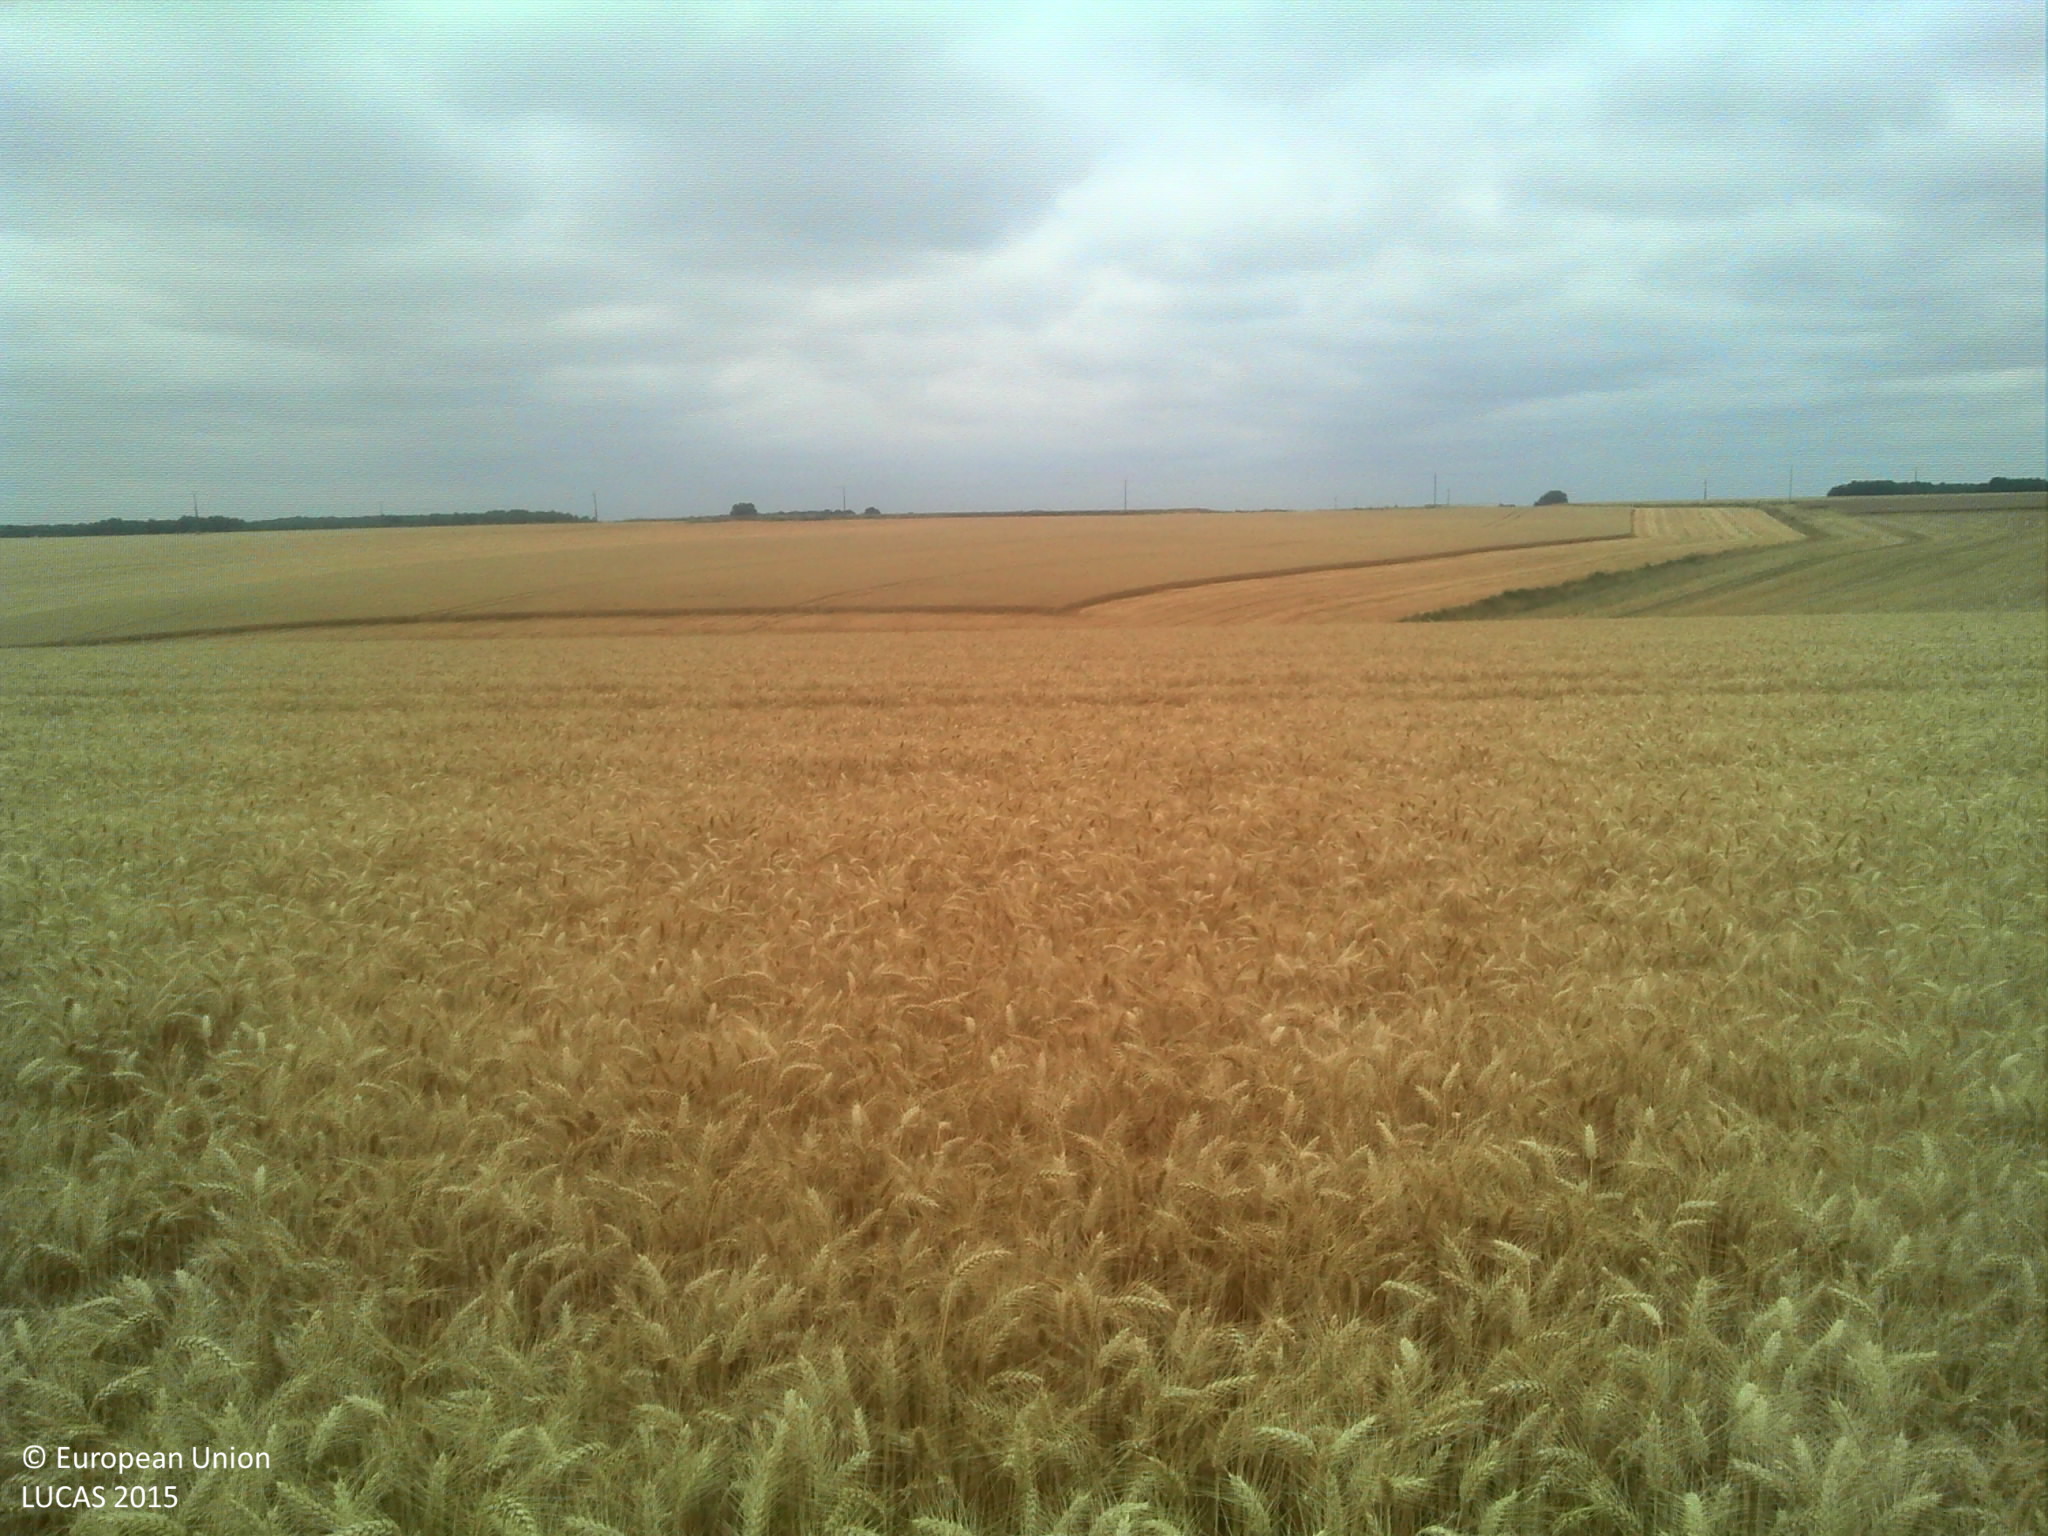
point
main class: Cropland
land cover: Common wheat
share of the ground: > 75 %
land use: Agriculture (excluding fallow land and kitchen gardens)
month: July
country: FR
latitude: 47.7244
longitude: 0.7407
